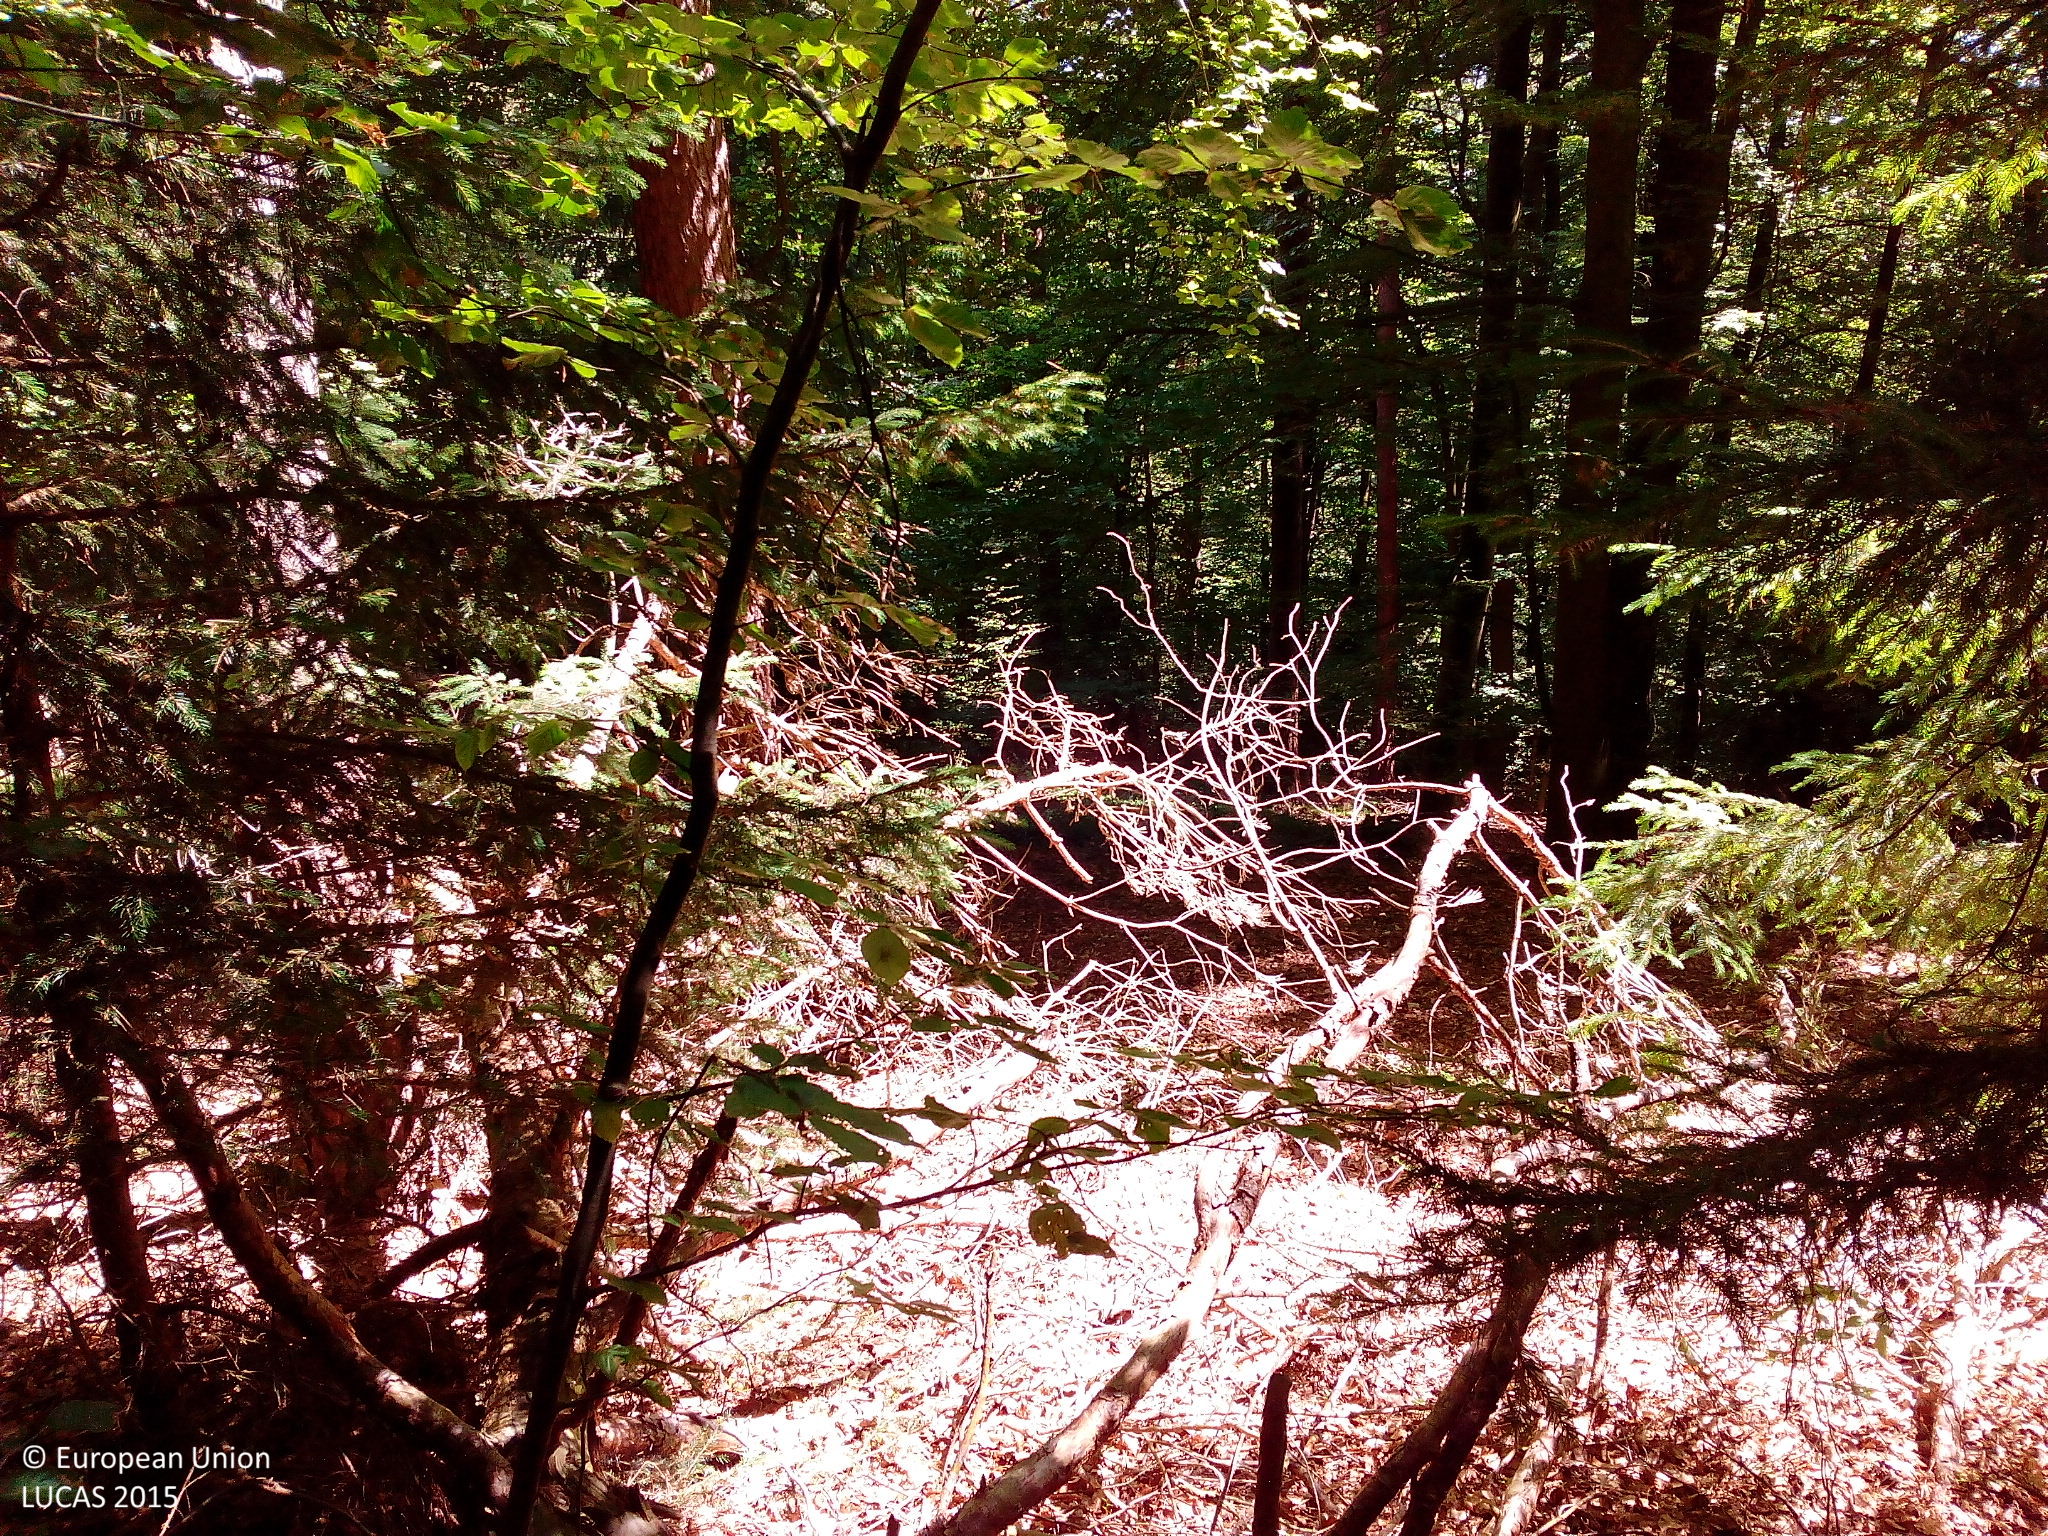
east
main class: Woodland
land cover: Pine dominated mixed woodland
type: hemiboreal forest and nemoral coniferous forest and mixed broadleaved-coniferous forest
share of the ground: > 75 %
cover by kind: coniferous forest trees 50 %, broadleaved forest trees 50 %
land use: Forestry
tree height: > 5 m
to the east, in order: Pine dominated mixed woodland; Tracks; Pine dominated mixed woodland; Paved roads, cycling and walking lanes; Pine dominated mixed woodland; Fences; Grassland without tree/shrub cover
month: July
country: DE
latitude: 50.9214
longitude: 9.9573
